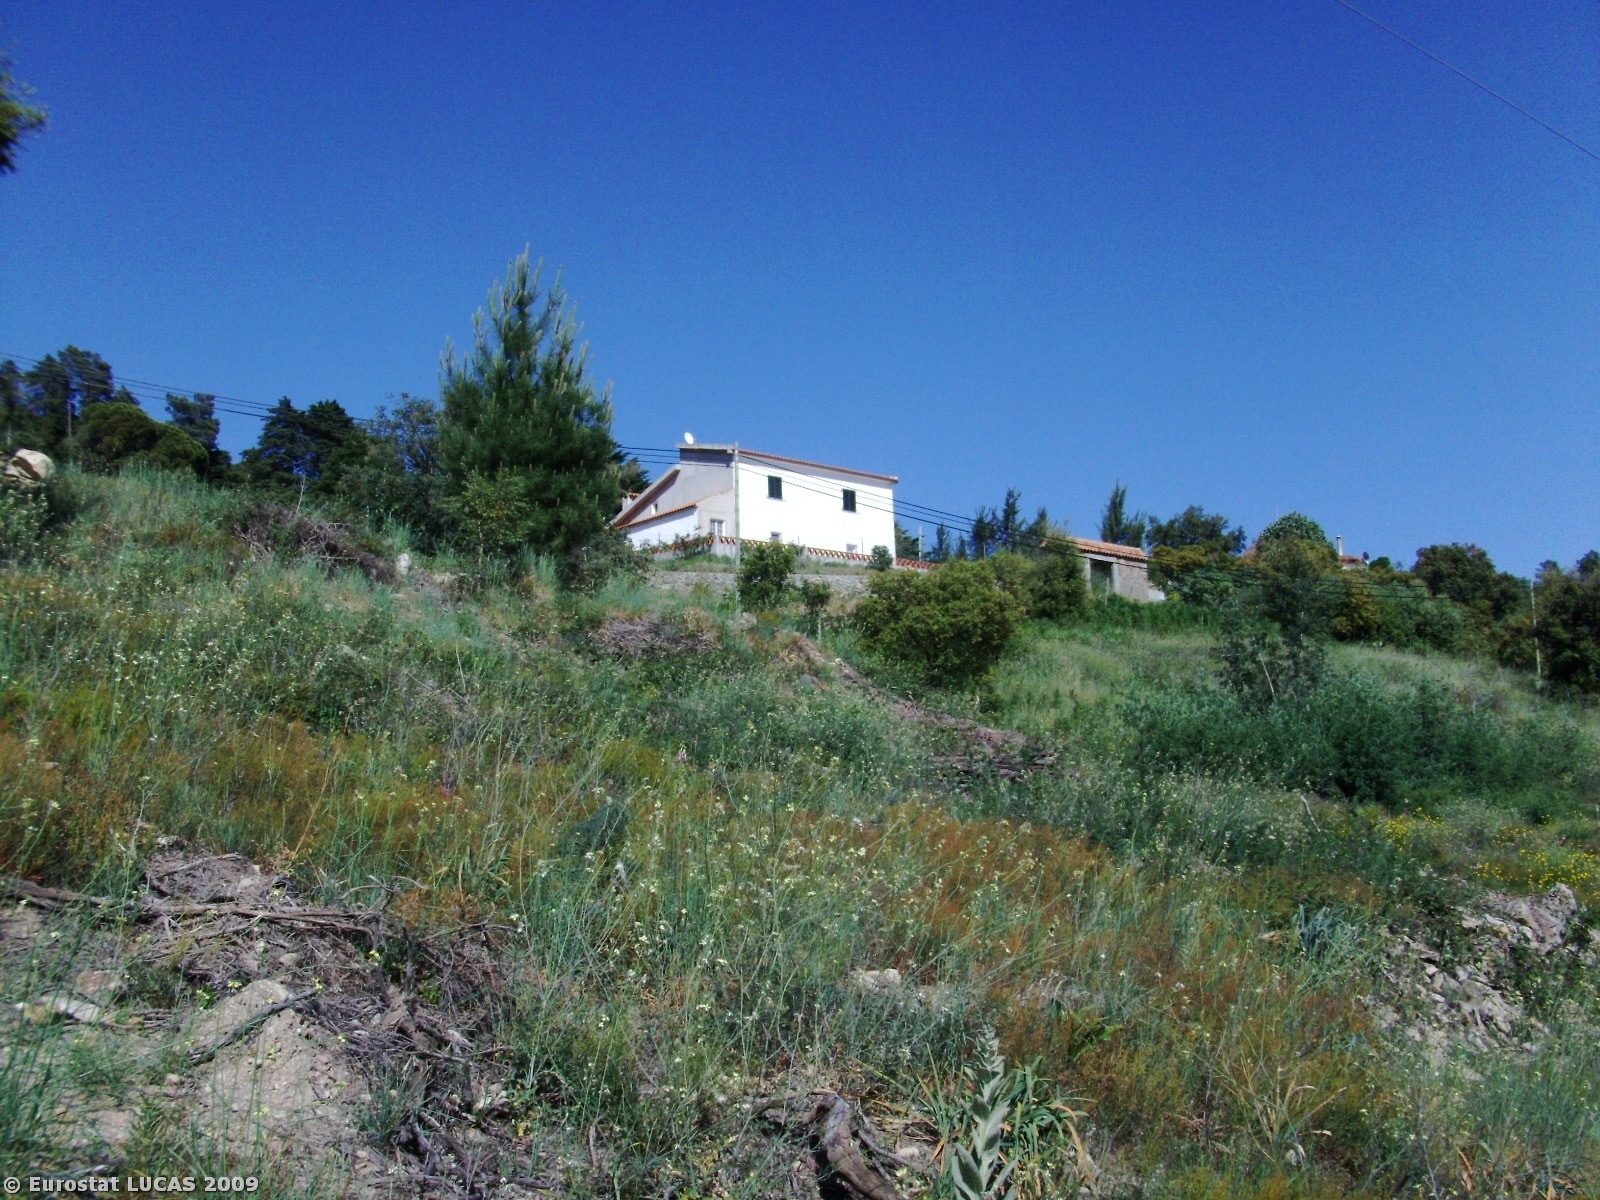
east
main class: Grassland
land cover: Grassland with sparse tree/shrub cover
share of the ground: 50 - 75 %
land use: Forestry
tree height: > 5 m
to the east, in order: Grassland with sparse tree/shrub cover; Electric lines; Tracks; Shrubland with sparse tree cover; Artificial constructions in urban areas; Paved roads, cycling and walking lanes; Olive groves
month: May
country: PT
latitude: 39.3036
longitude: -7.4245
